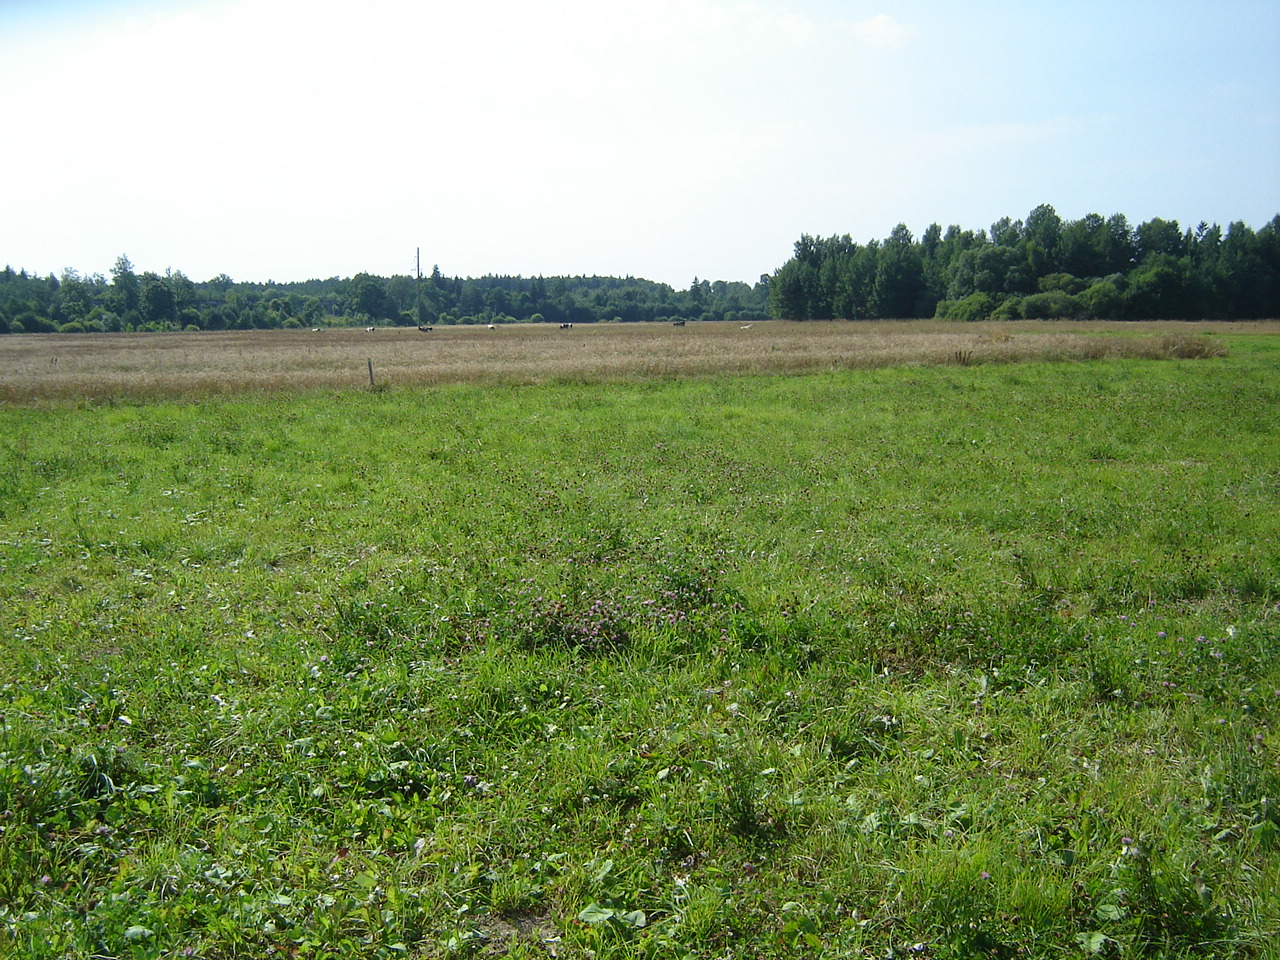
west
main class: Grassland
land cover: Grassland without tree/shrub cover
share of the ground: > 75 %
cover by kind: herbaceous plants 100 %
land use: Agriculture (excluding fallow land and kitchen gardens)
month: August
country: LT
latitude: 55.0289
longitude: 24.9588
